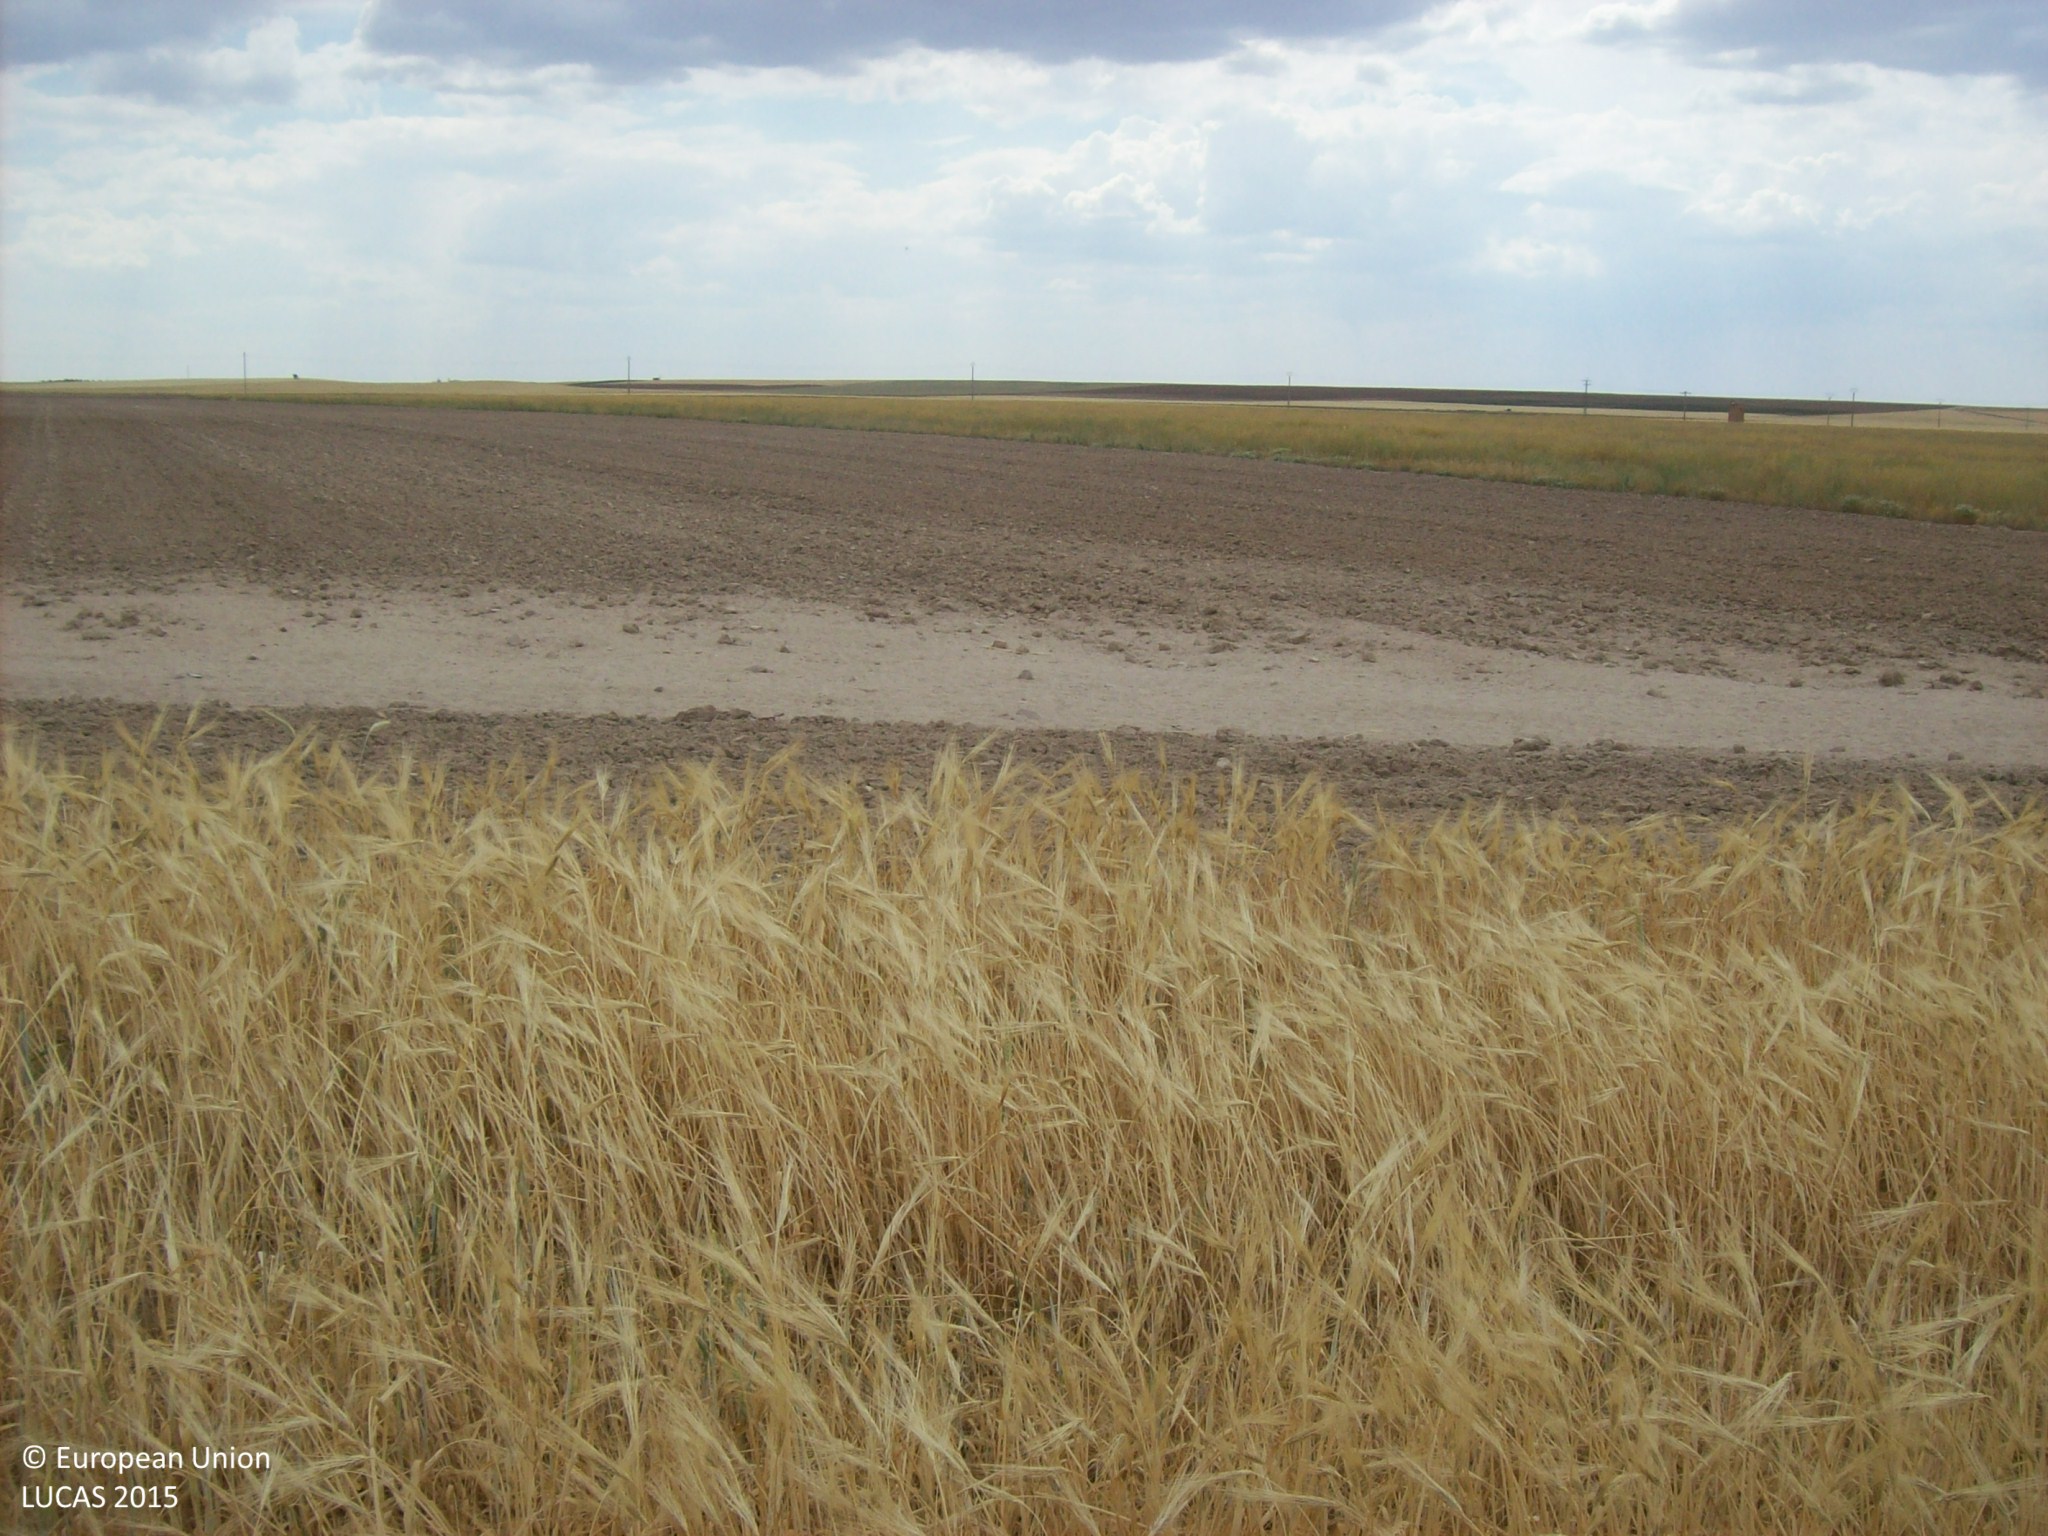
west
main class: Cropland
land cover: Barley
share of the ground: > 75 %
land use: Agriculture (excluding fallow land and kitchen gardens)
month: June
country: ES
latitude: 41.0849
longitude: -5.0301
